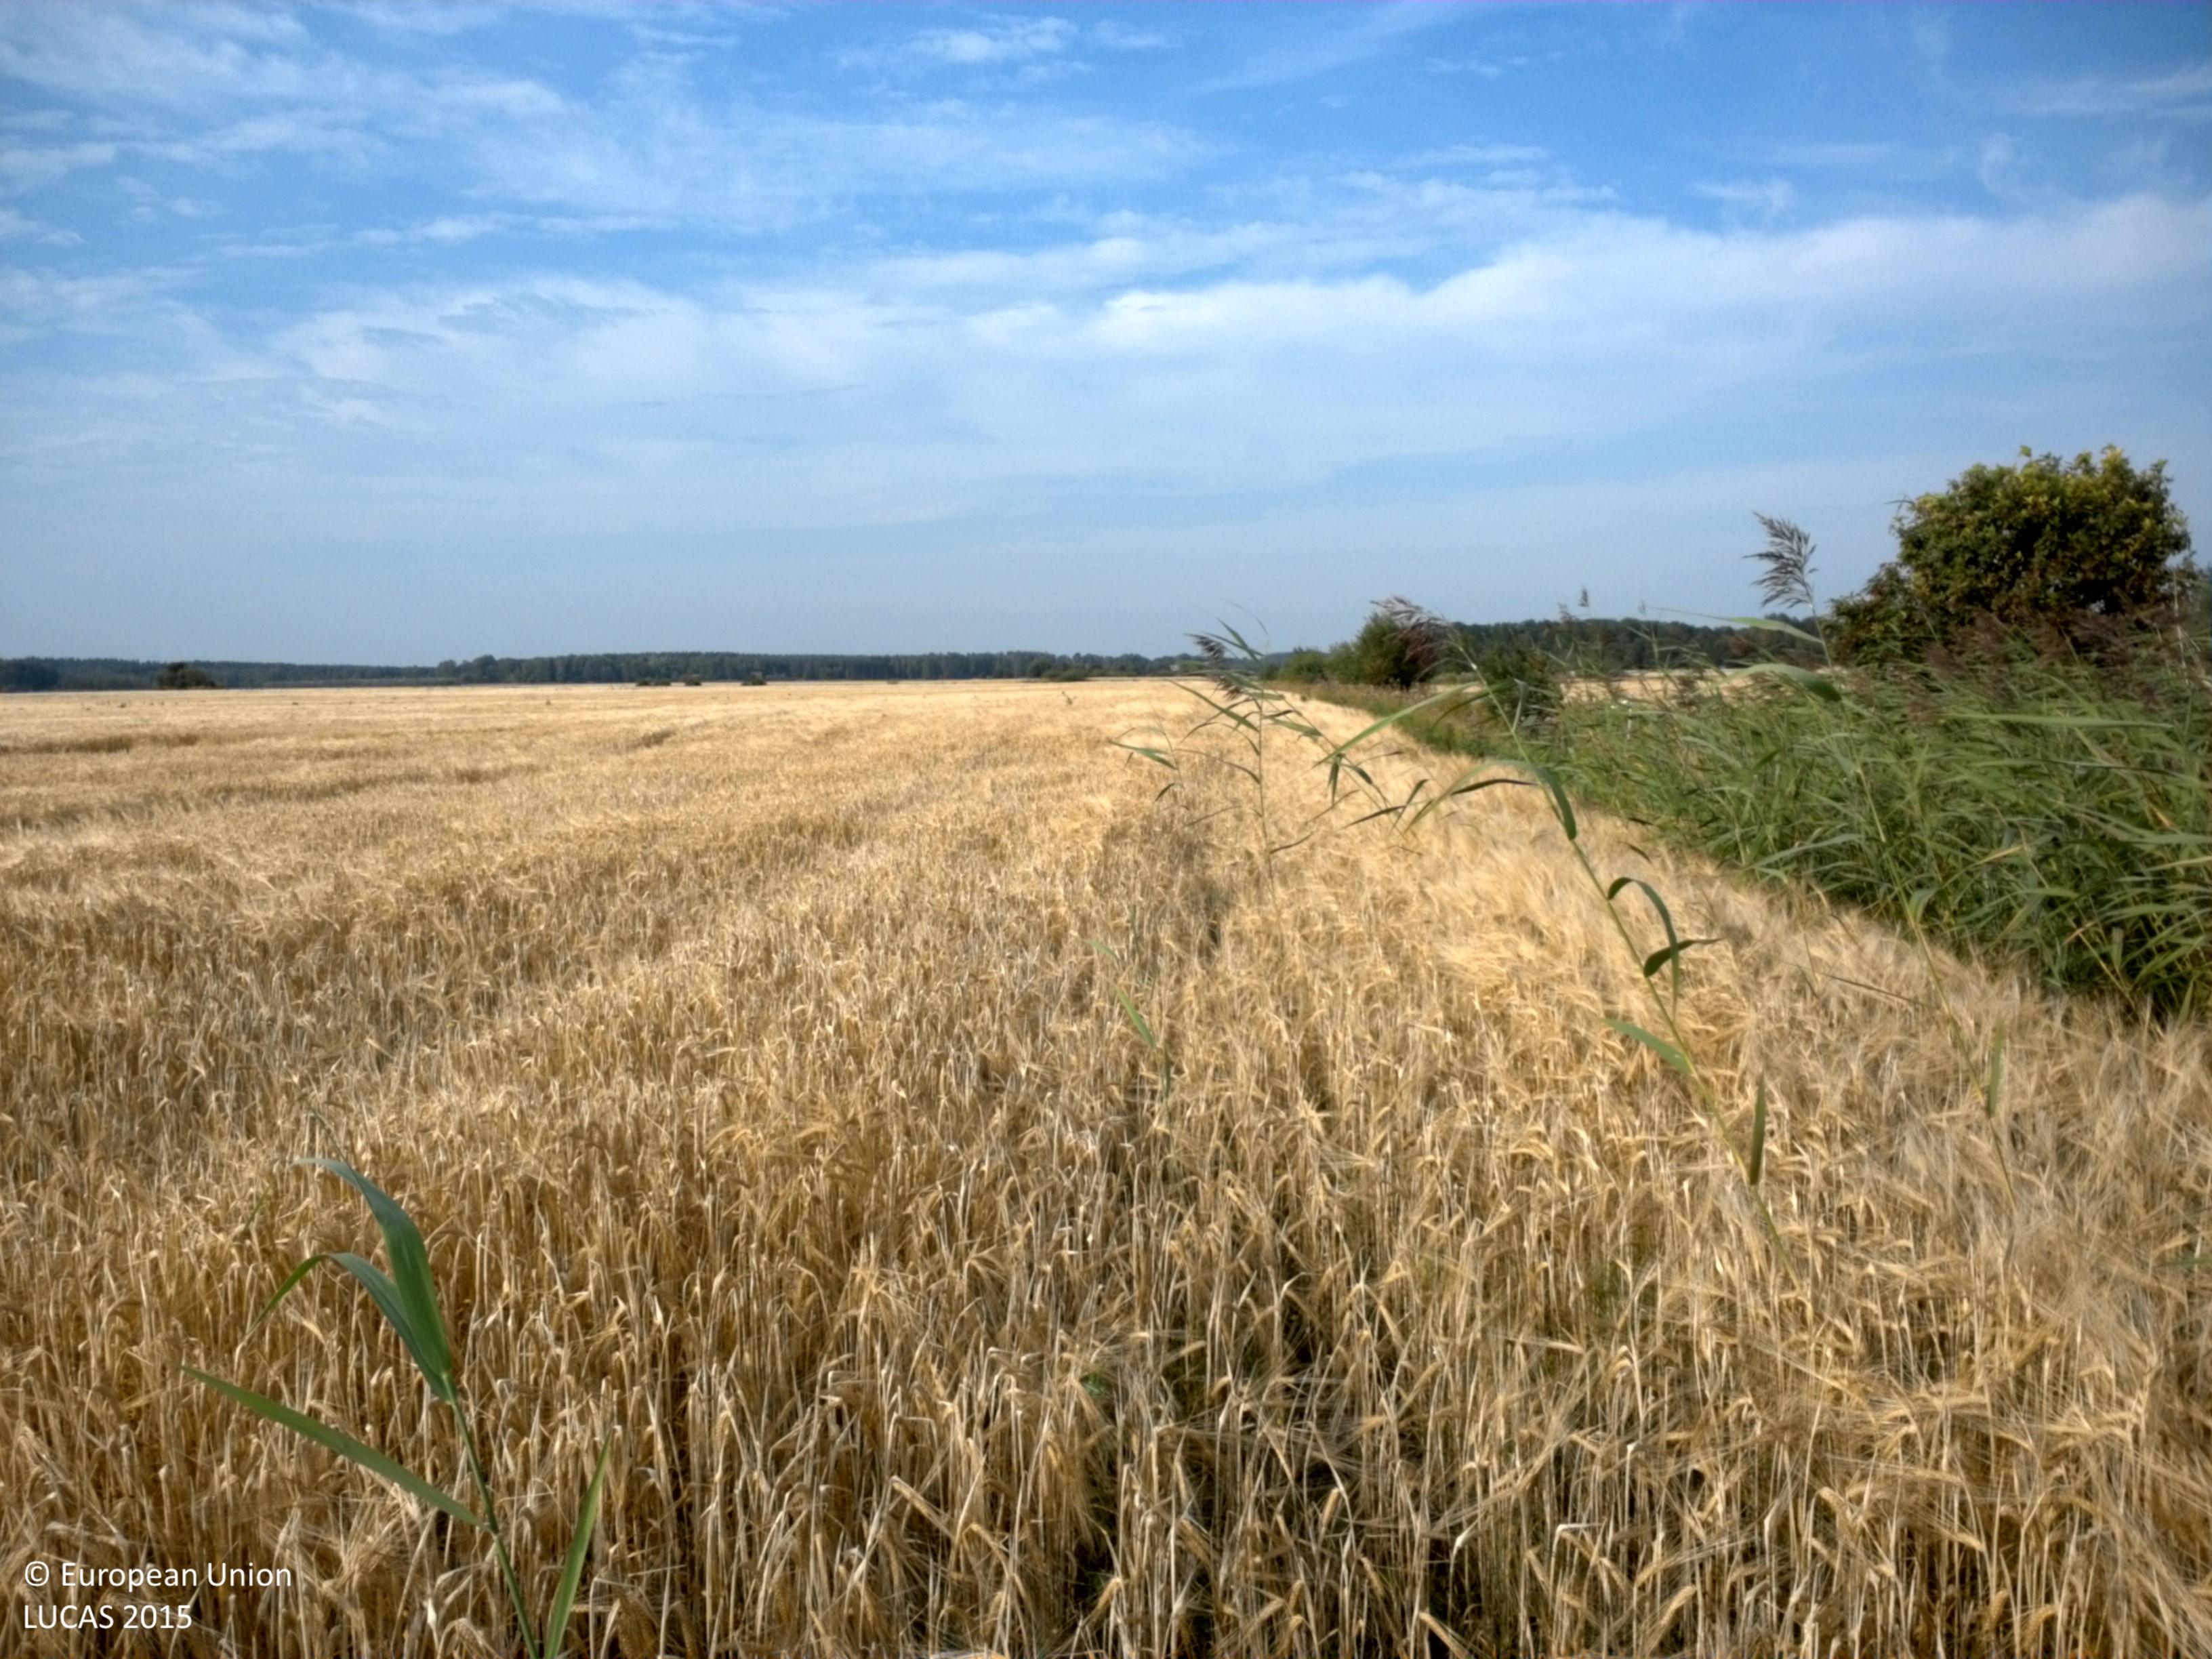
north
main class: Cropland
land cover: Barley
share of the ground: > 75 %
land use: Agriculture (excluding fallow land and kitchen gardens)
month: August
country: SE
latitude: 60.0486
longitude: 17.5889
